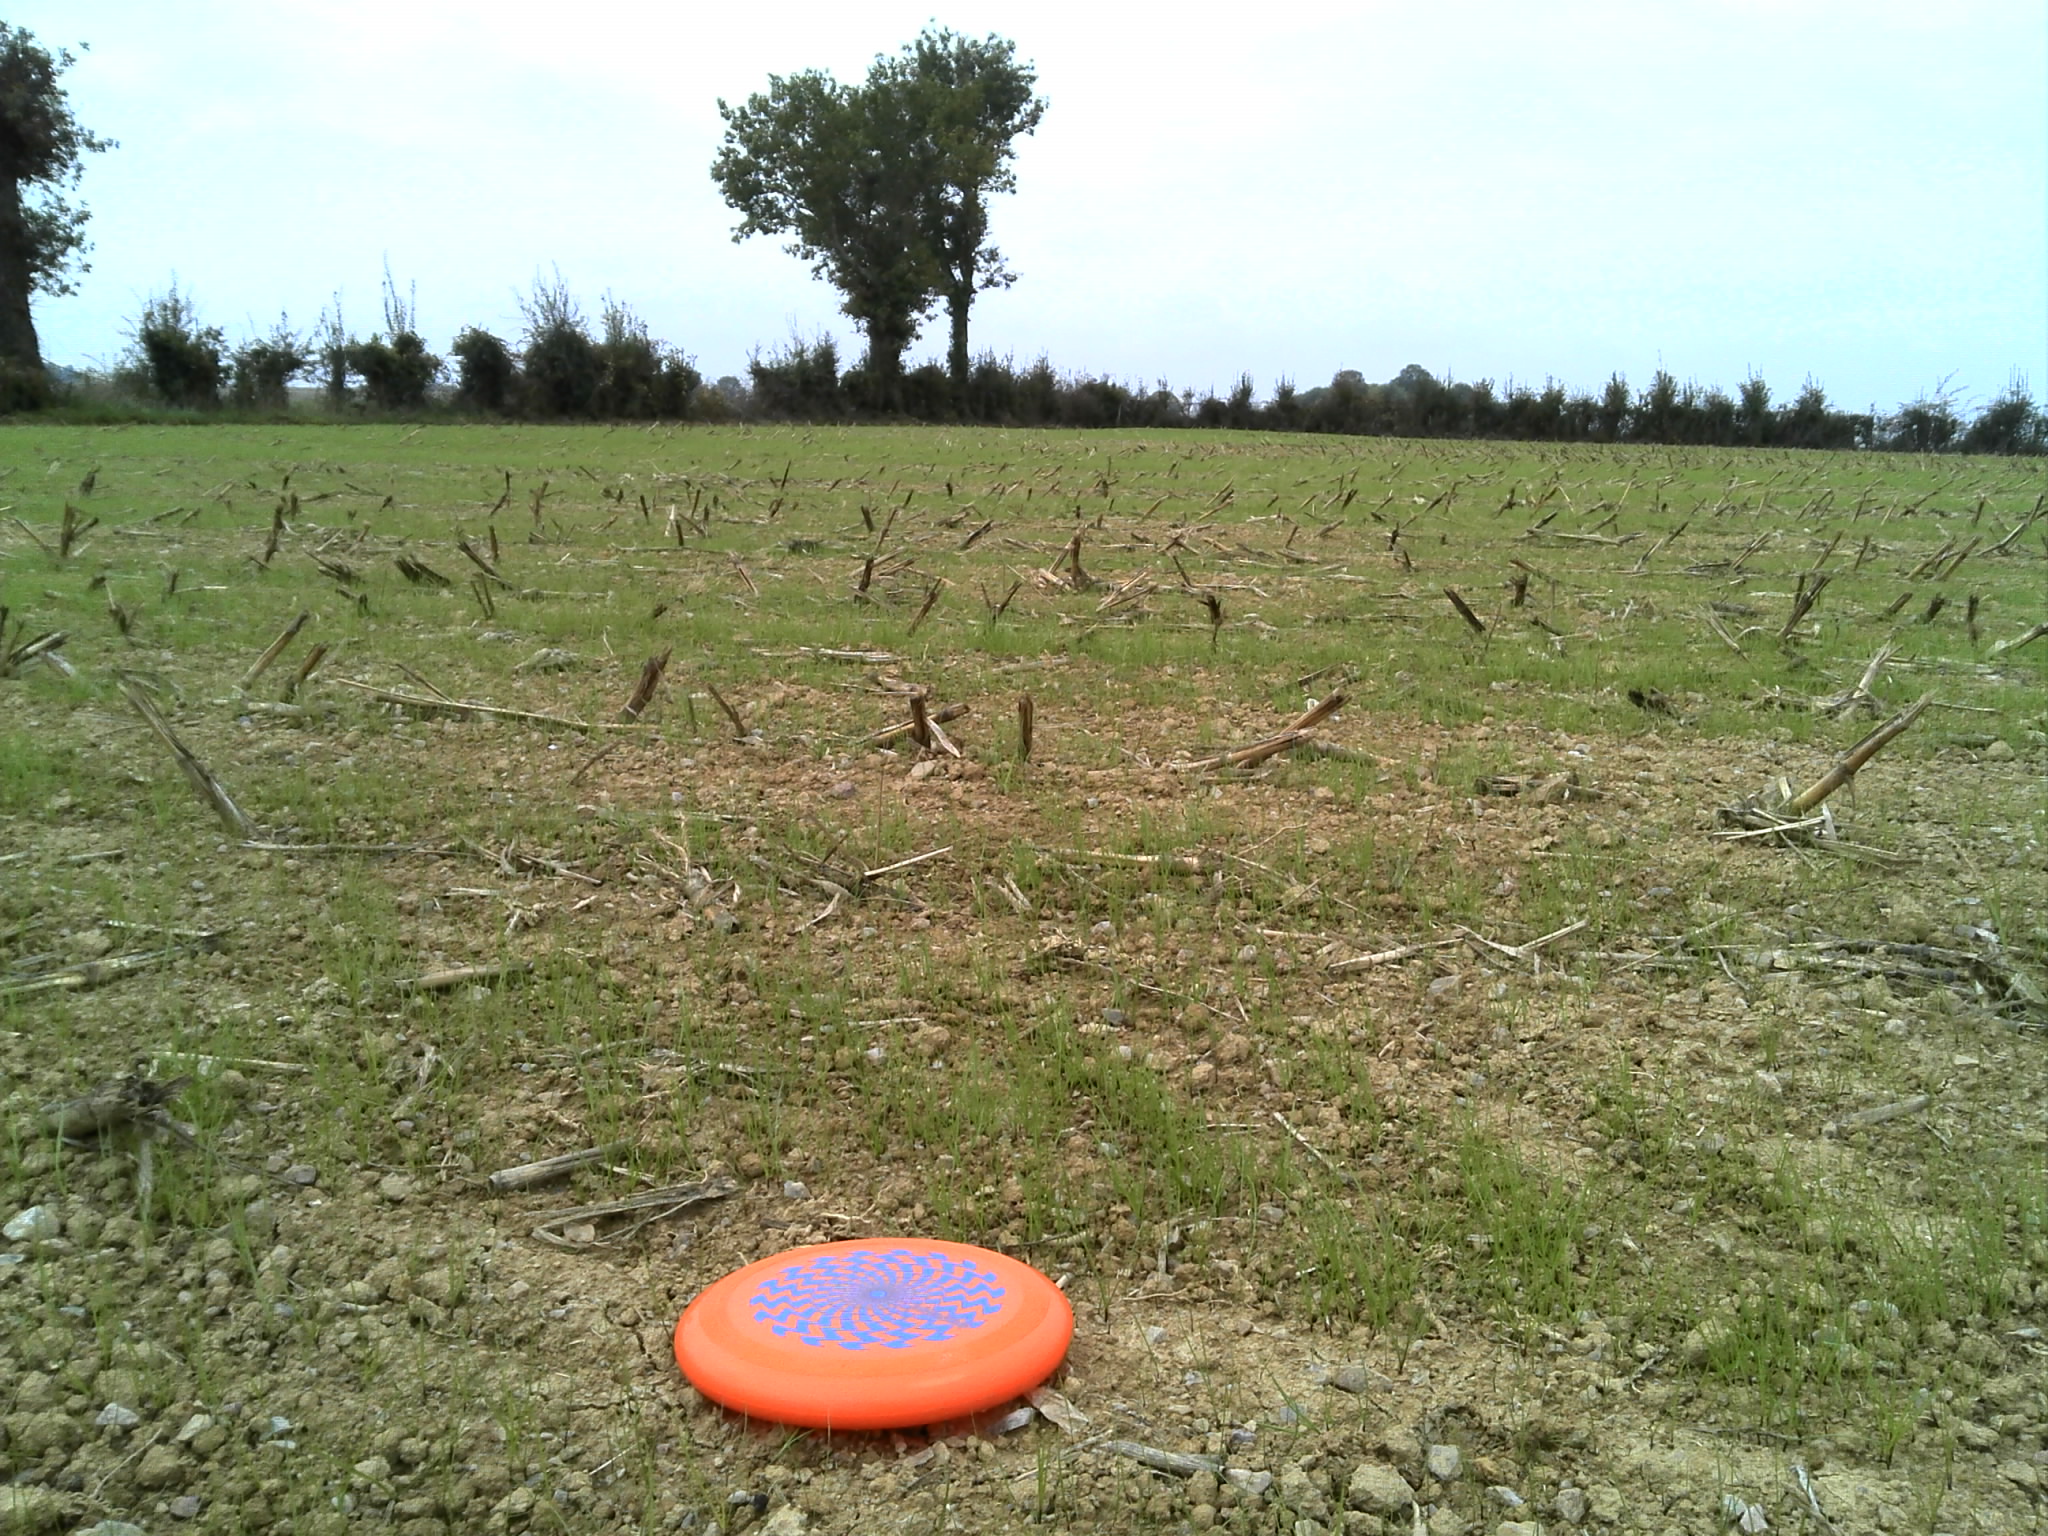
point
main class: Cropland
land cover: Temporary grasslands
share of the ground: 10 - 25 %
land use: Agriculture (excluding fallow land and kitchen gardens)
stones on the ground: 10 - 25 %
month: October
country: FR
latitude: 47.2573
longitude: -0.9636
